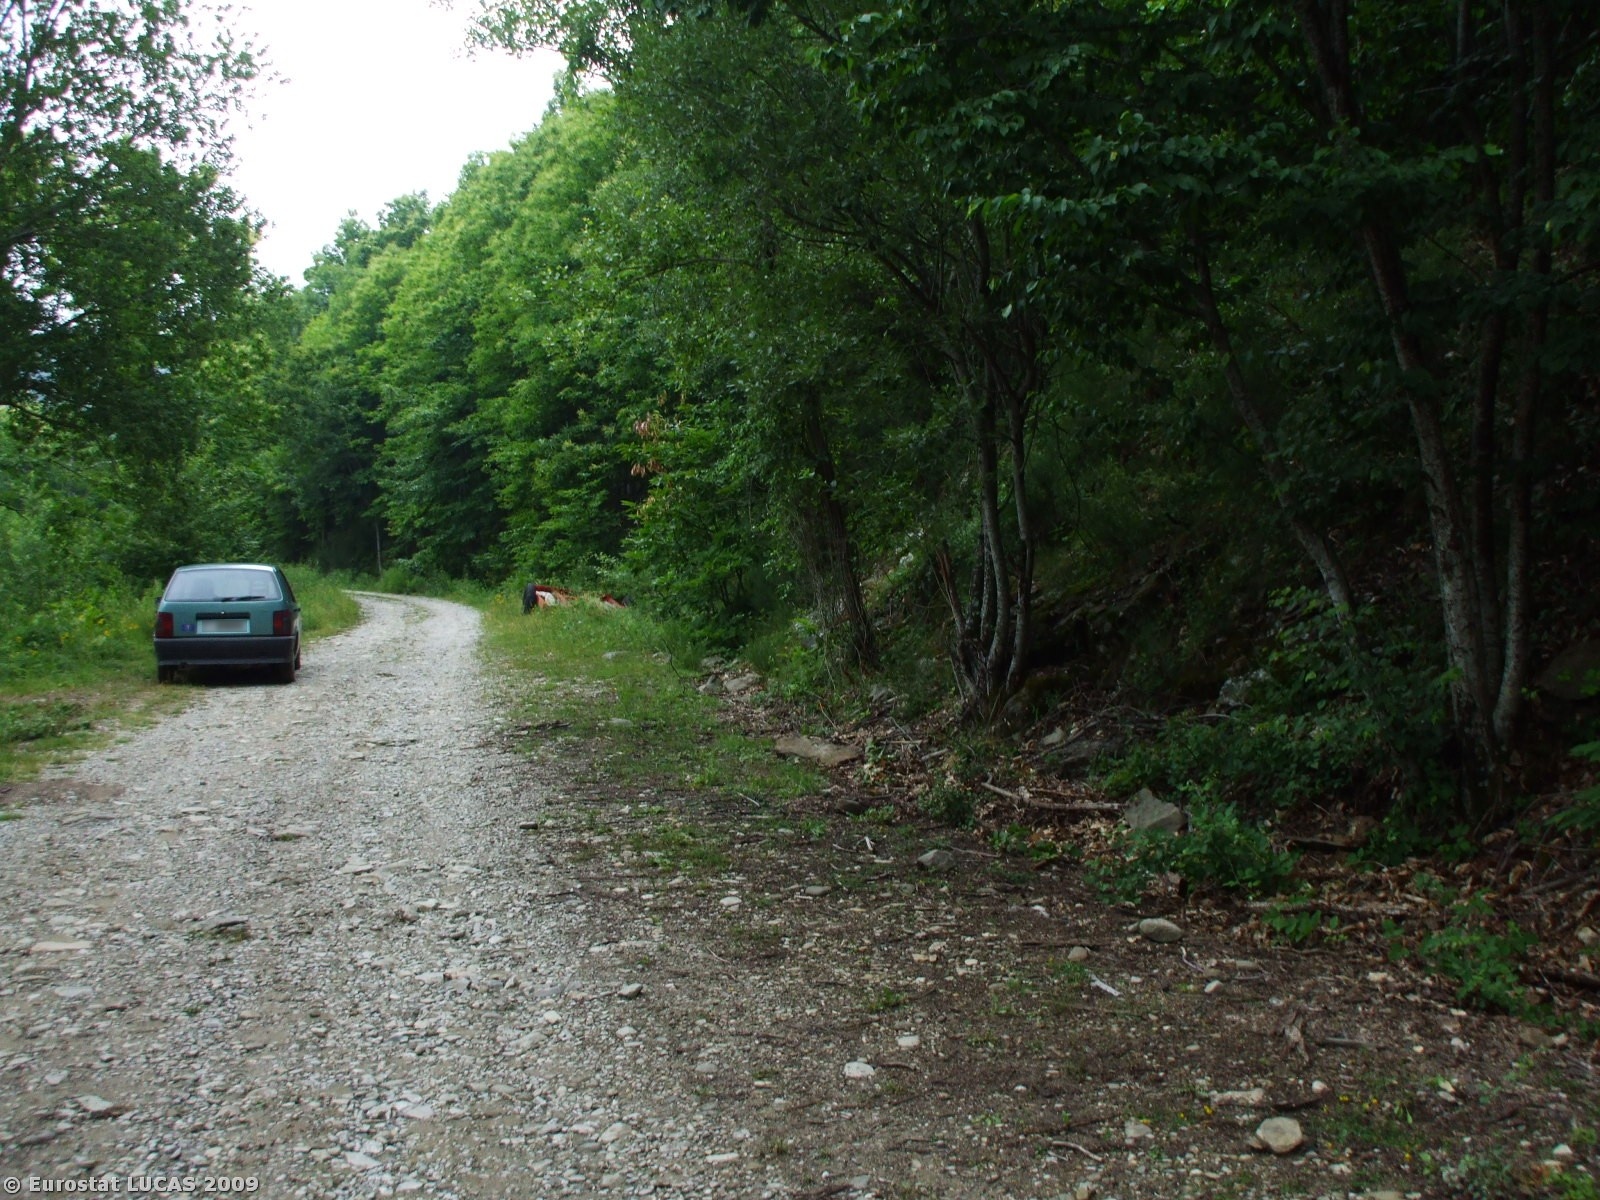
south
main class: Woodland
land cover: Broadleaved woodland
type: thermophilous deciduous forest
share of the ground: > 75 %
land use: Forestry
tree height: > 5 m
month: June
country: IT
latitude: 43.6691
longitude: 11.6946
